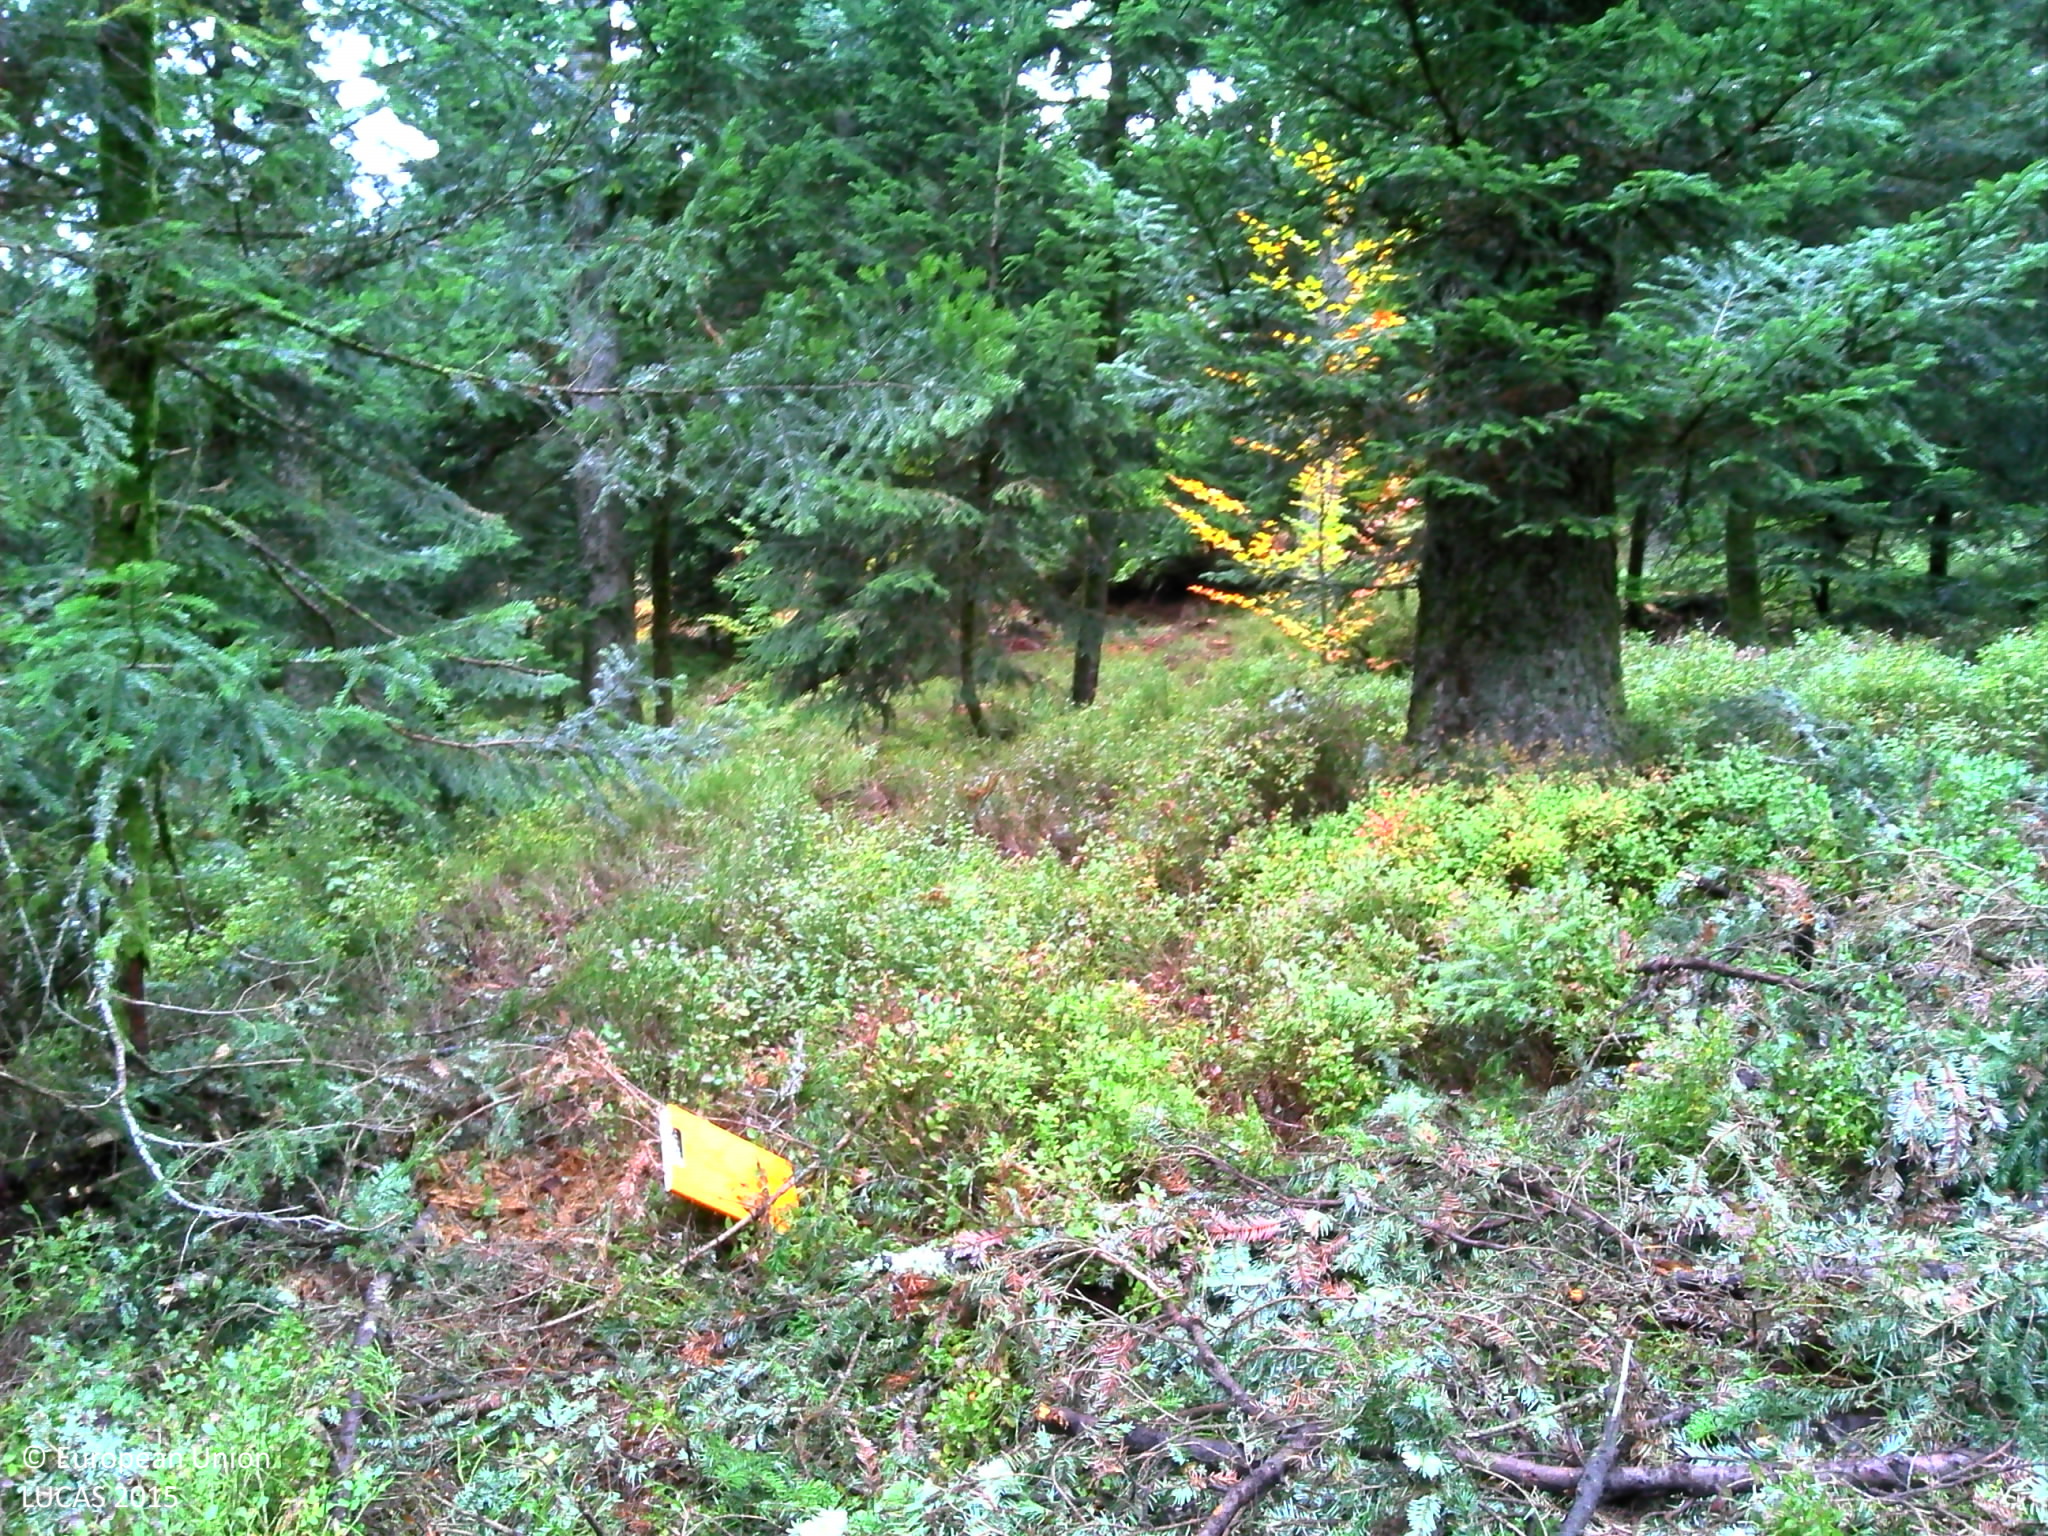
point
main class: Woodland
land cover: Other mixed woodland
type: alpine coniferous forest
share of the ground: 50 - 75 %
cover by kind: coniferous forest trees 45 %, shrubs 25 %, broadleaved forest trees 15 %, lichens and mosses 10 %, herbaceous plants 5 %
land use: Forestry
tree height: > 5 m
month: October
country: FR
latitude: 45.9467
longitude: 3.6670
